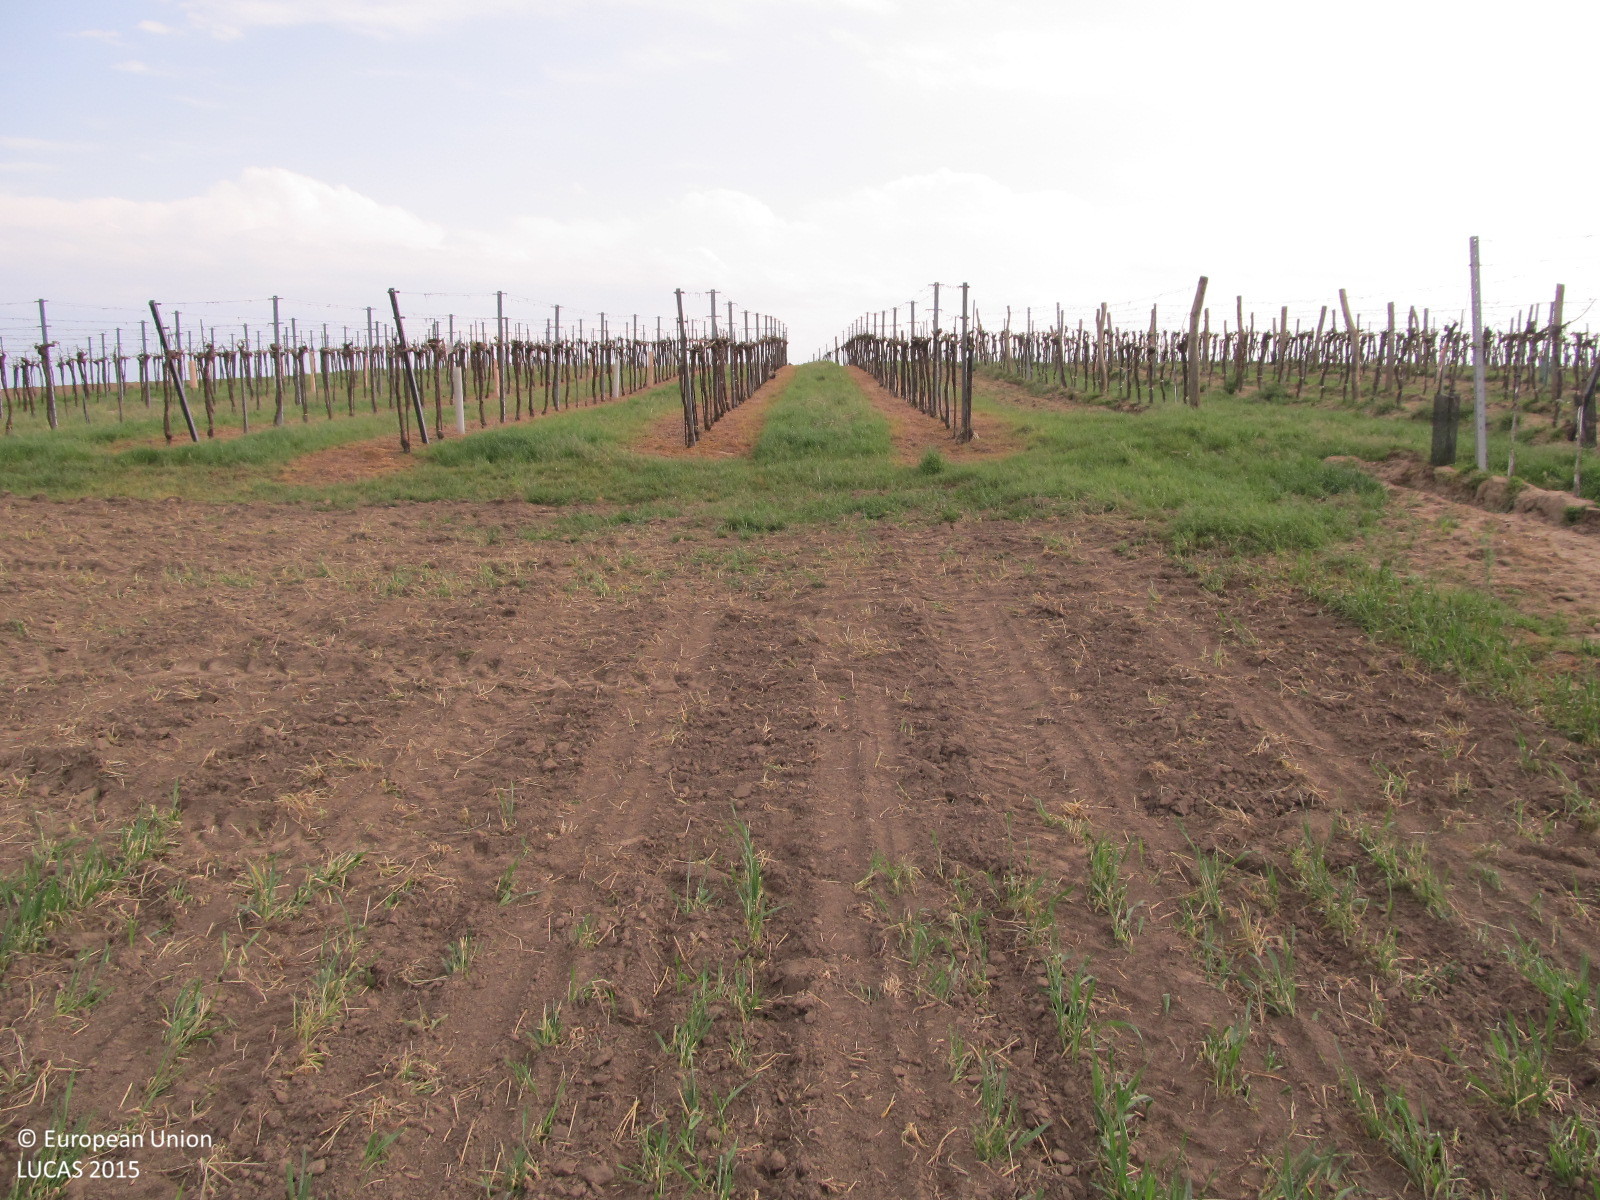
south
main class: Cropland
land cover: Maize
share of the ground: < 10 %
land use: Agriculture (excluding fallow land and kitchen gardens)
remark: Harvested field
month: May
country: AT
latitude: 48.4617
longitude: 15.9137
